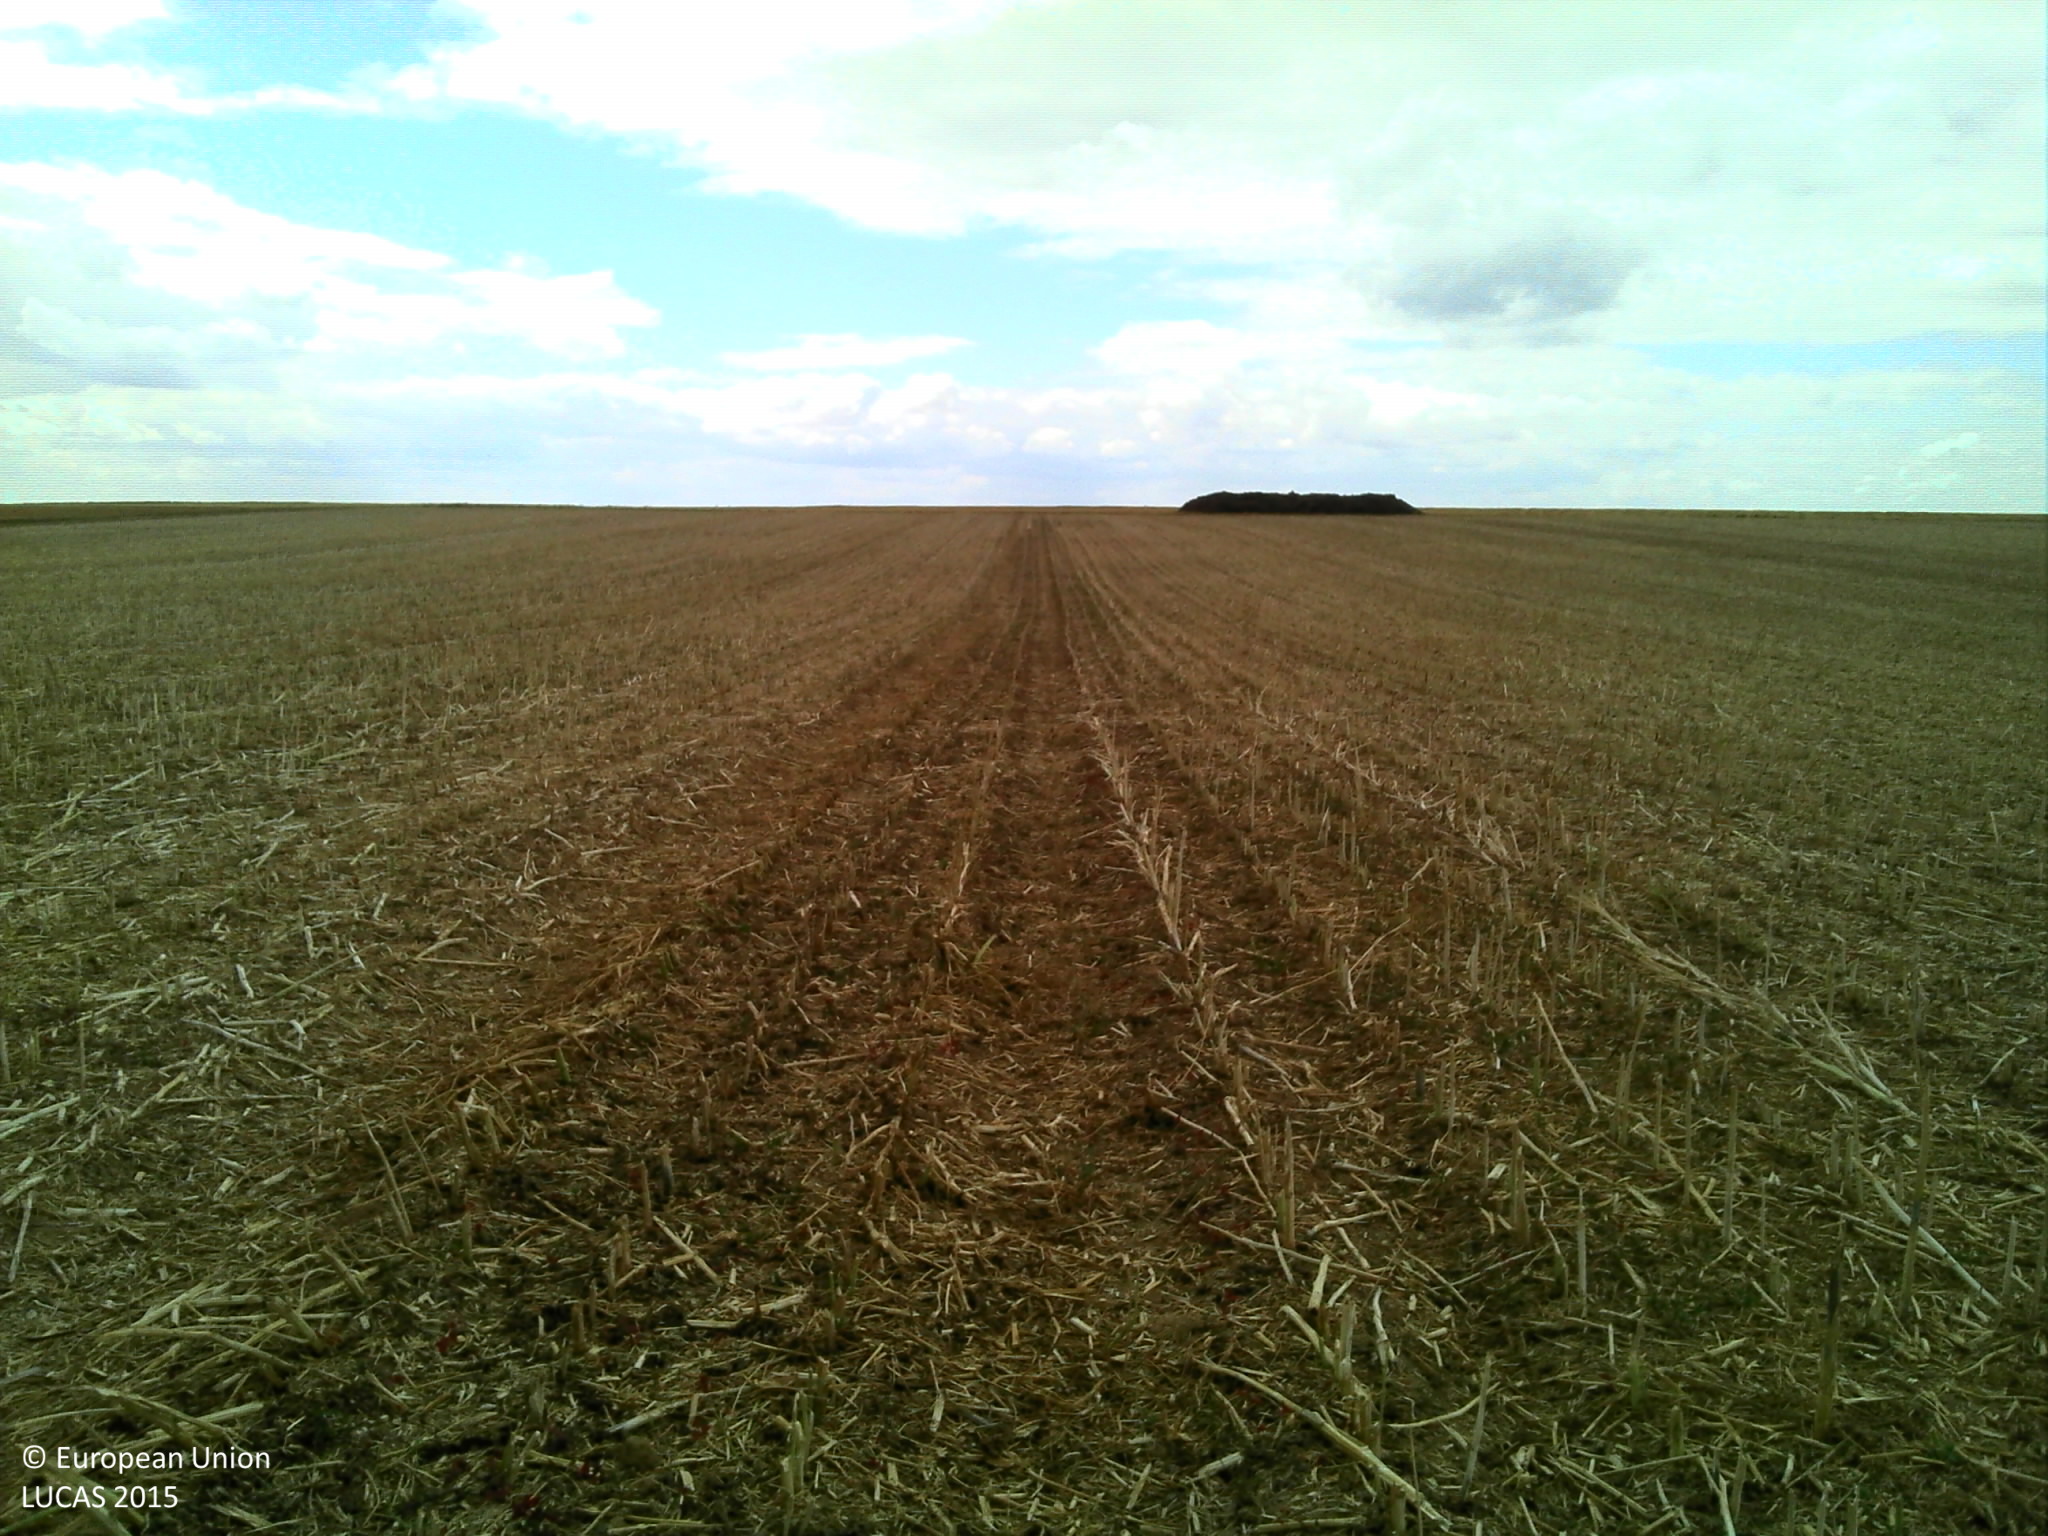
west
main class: Cropland
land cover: Rape and turnip rape
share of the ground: > 75 %
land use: Agriculture (excluding fallow land and kitchen gardens)
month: July
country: FR
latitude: 49.0990
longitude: 4.5594
